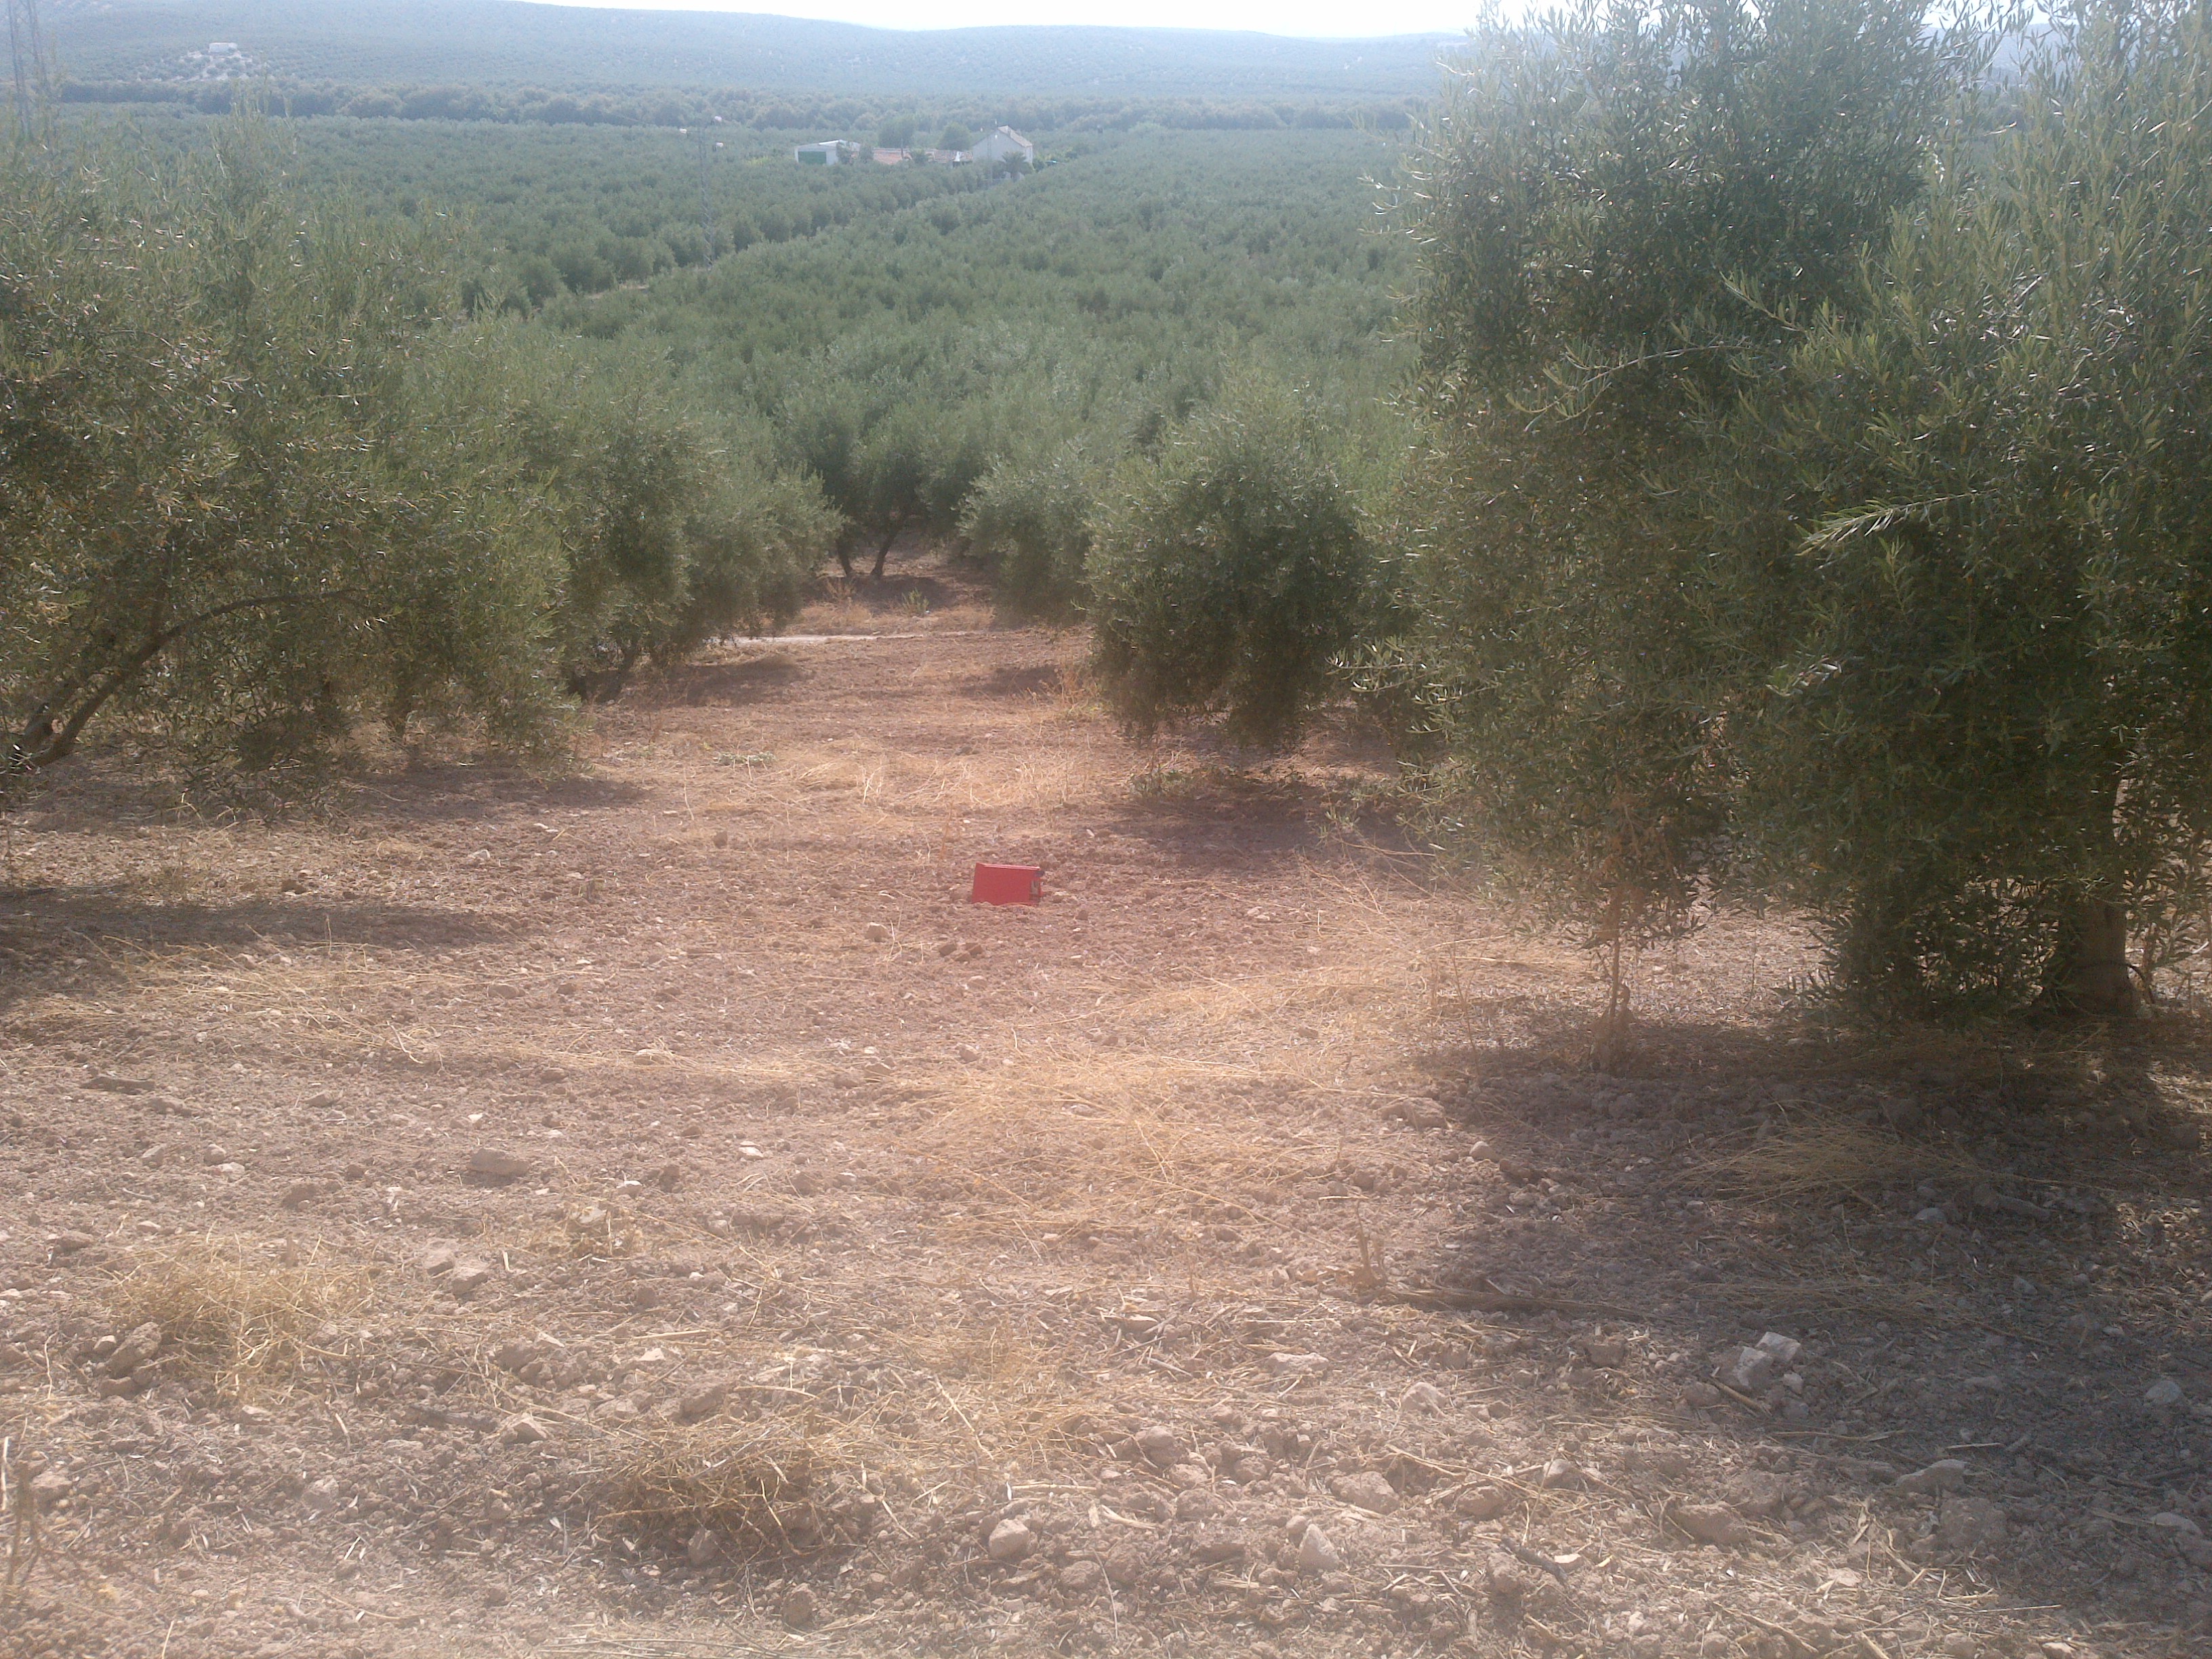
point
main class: Cropland
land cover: Olive groves
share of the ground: 50 - 75 %
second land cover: Other bare soil
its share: > 75 %
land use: Agriculture (excluding fallow land and kitchen gardens)
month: June
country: ES
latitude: 37.6782
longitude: -4.2569
